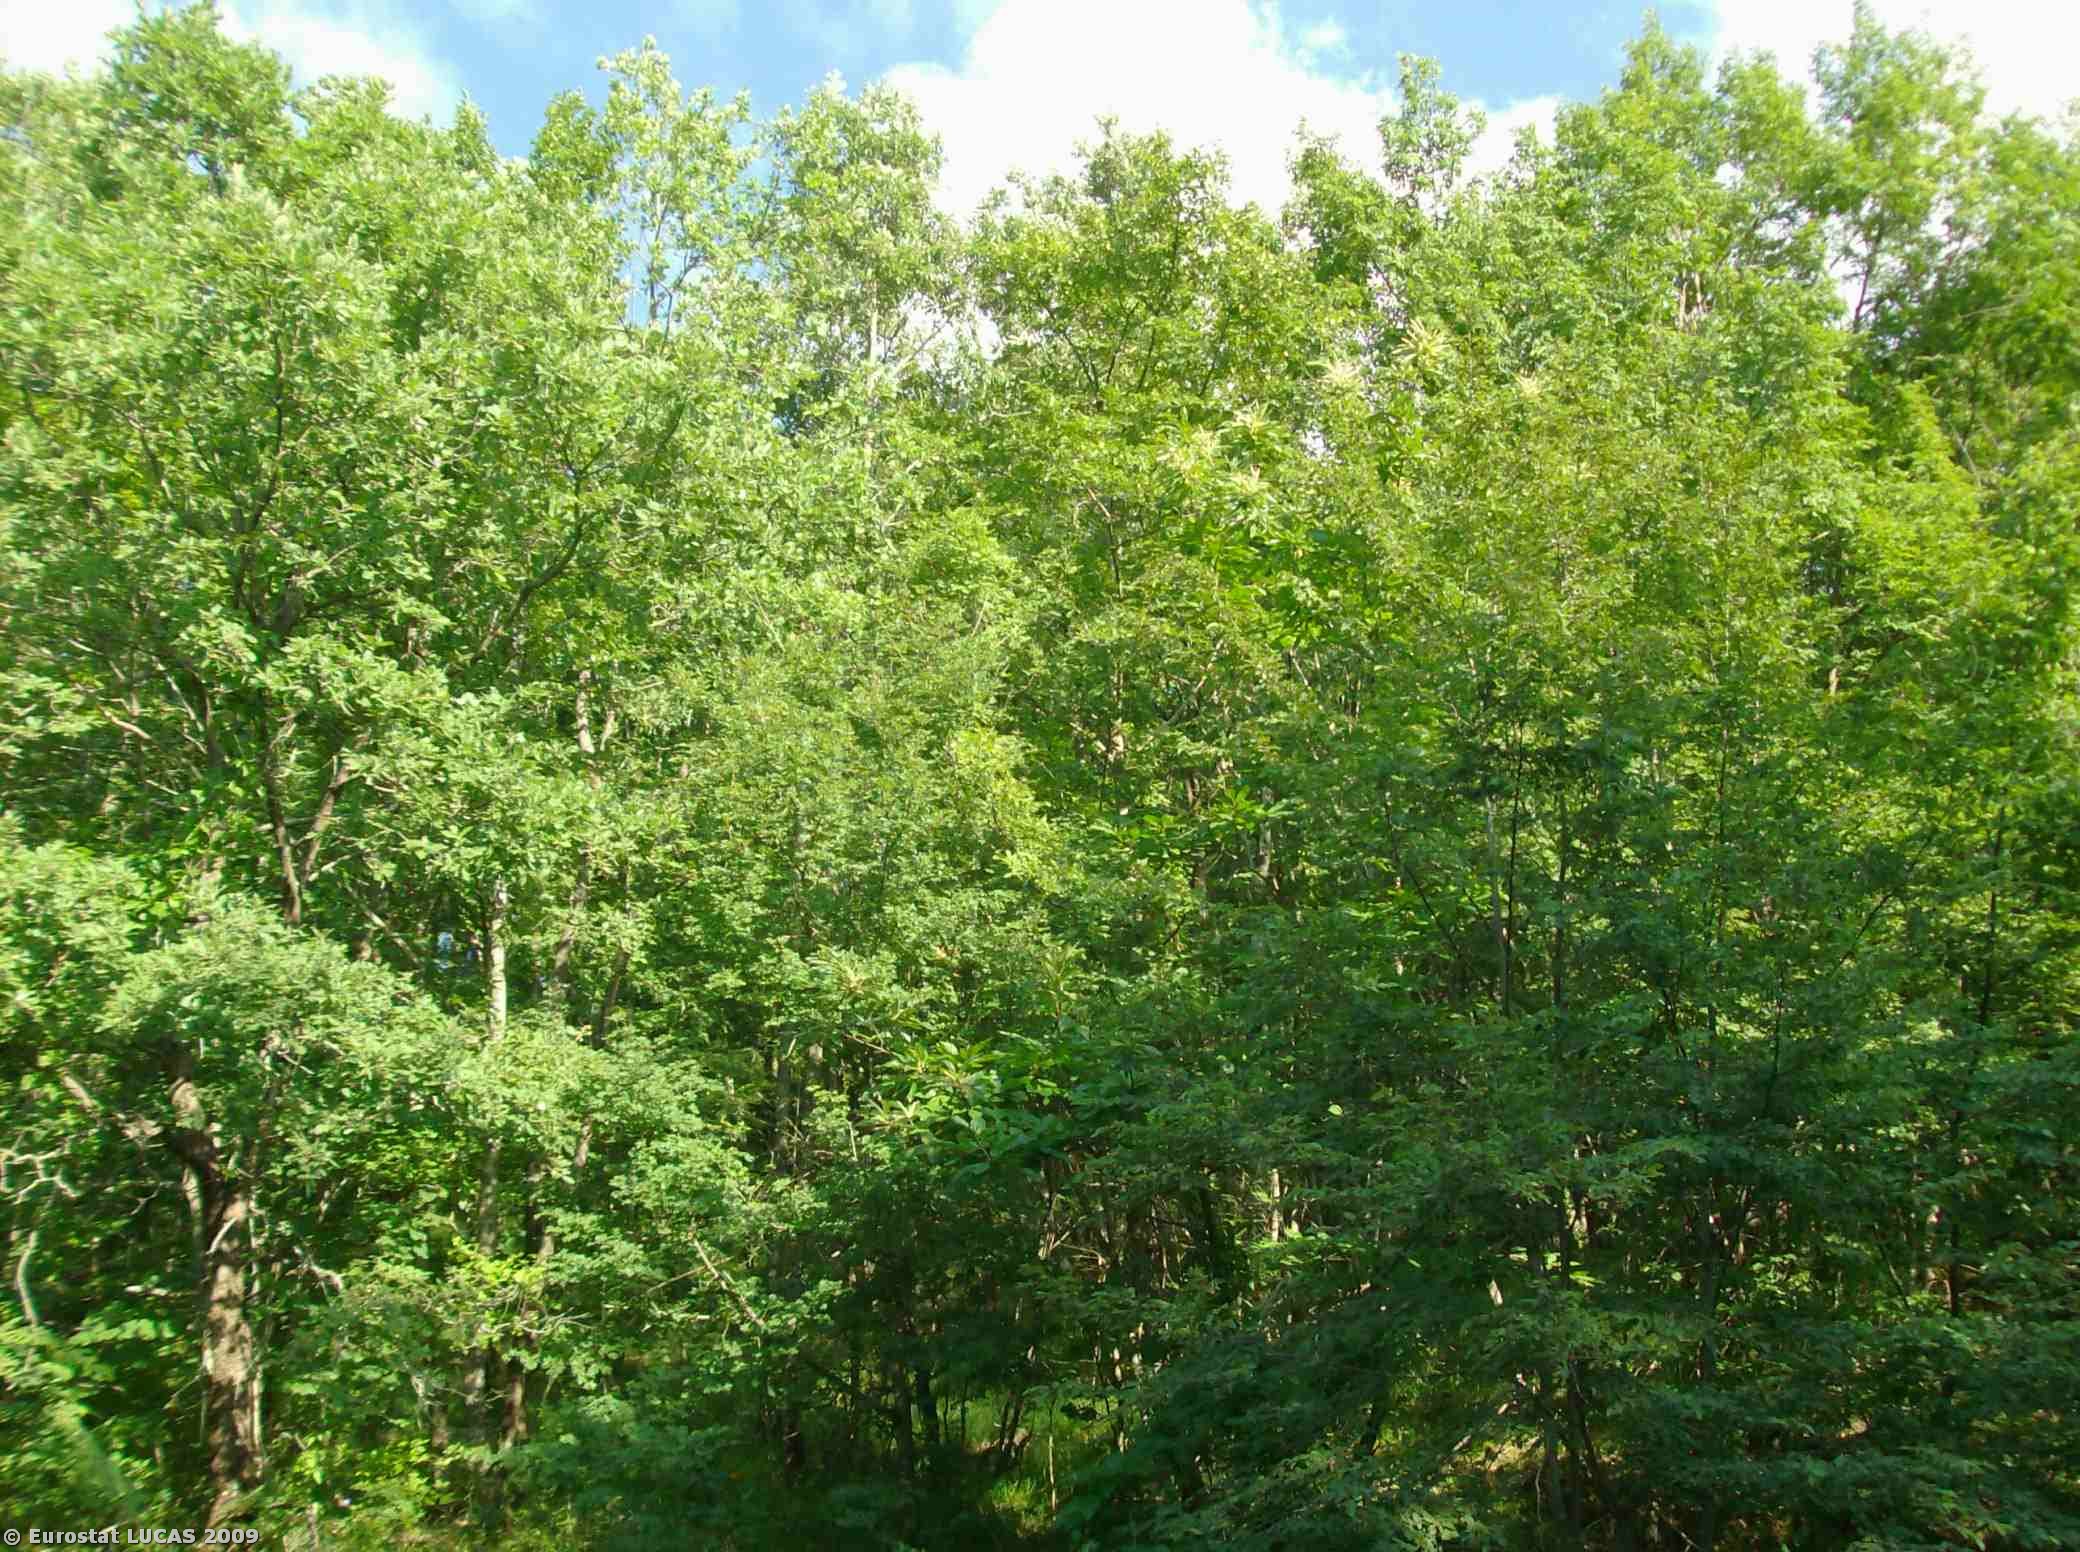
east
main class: Woodland
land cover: Broadleaved woodland
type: thermophilous deciduous forest
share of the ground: > 75 %
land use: Forestry
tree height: > 5 m
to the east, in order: Broadleaved woodland; Grass margins; Paved roads, cycling and walking lanes; Grass margins; Ditches and canals; Broadleaved woodland
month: June
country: IT
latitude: 42.8040
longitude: 11.5967
